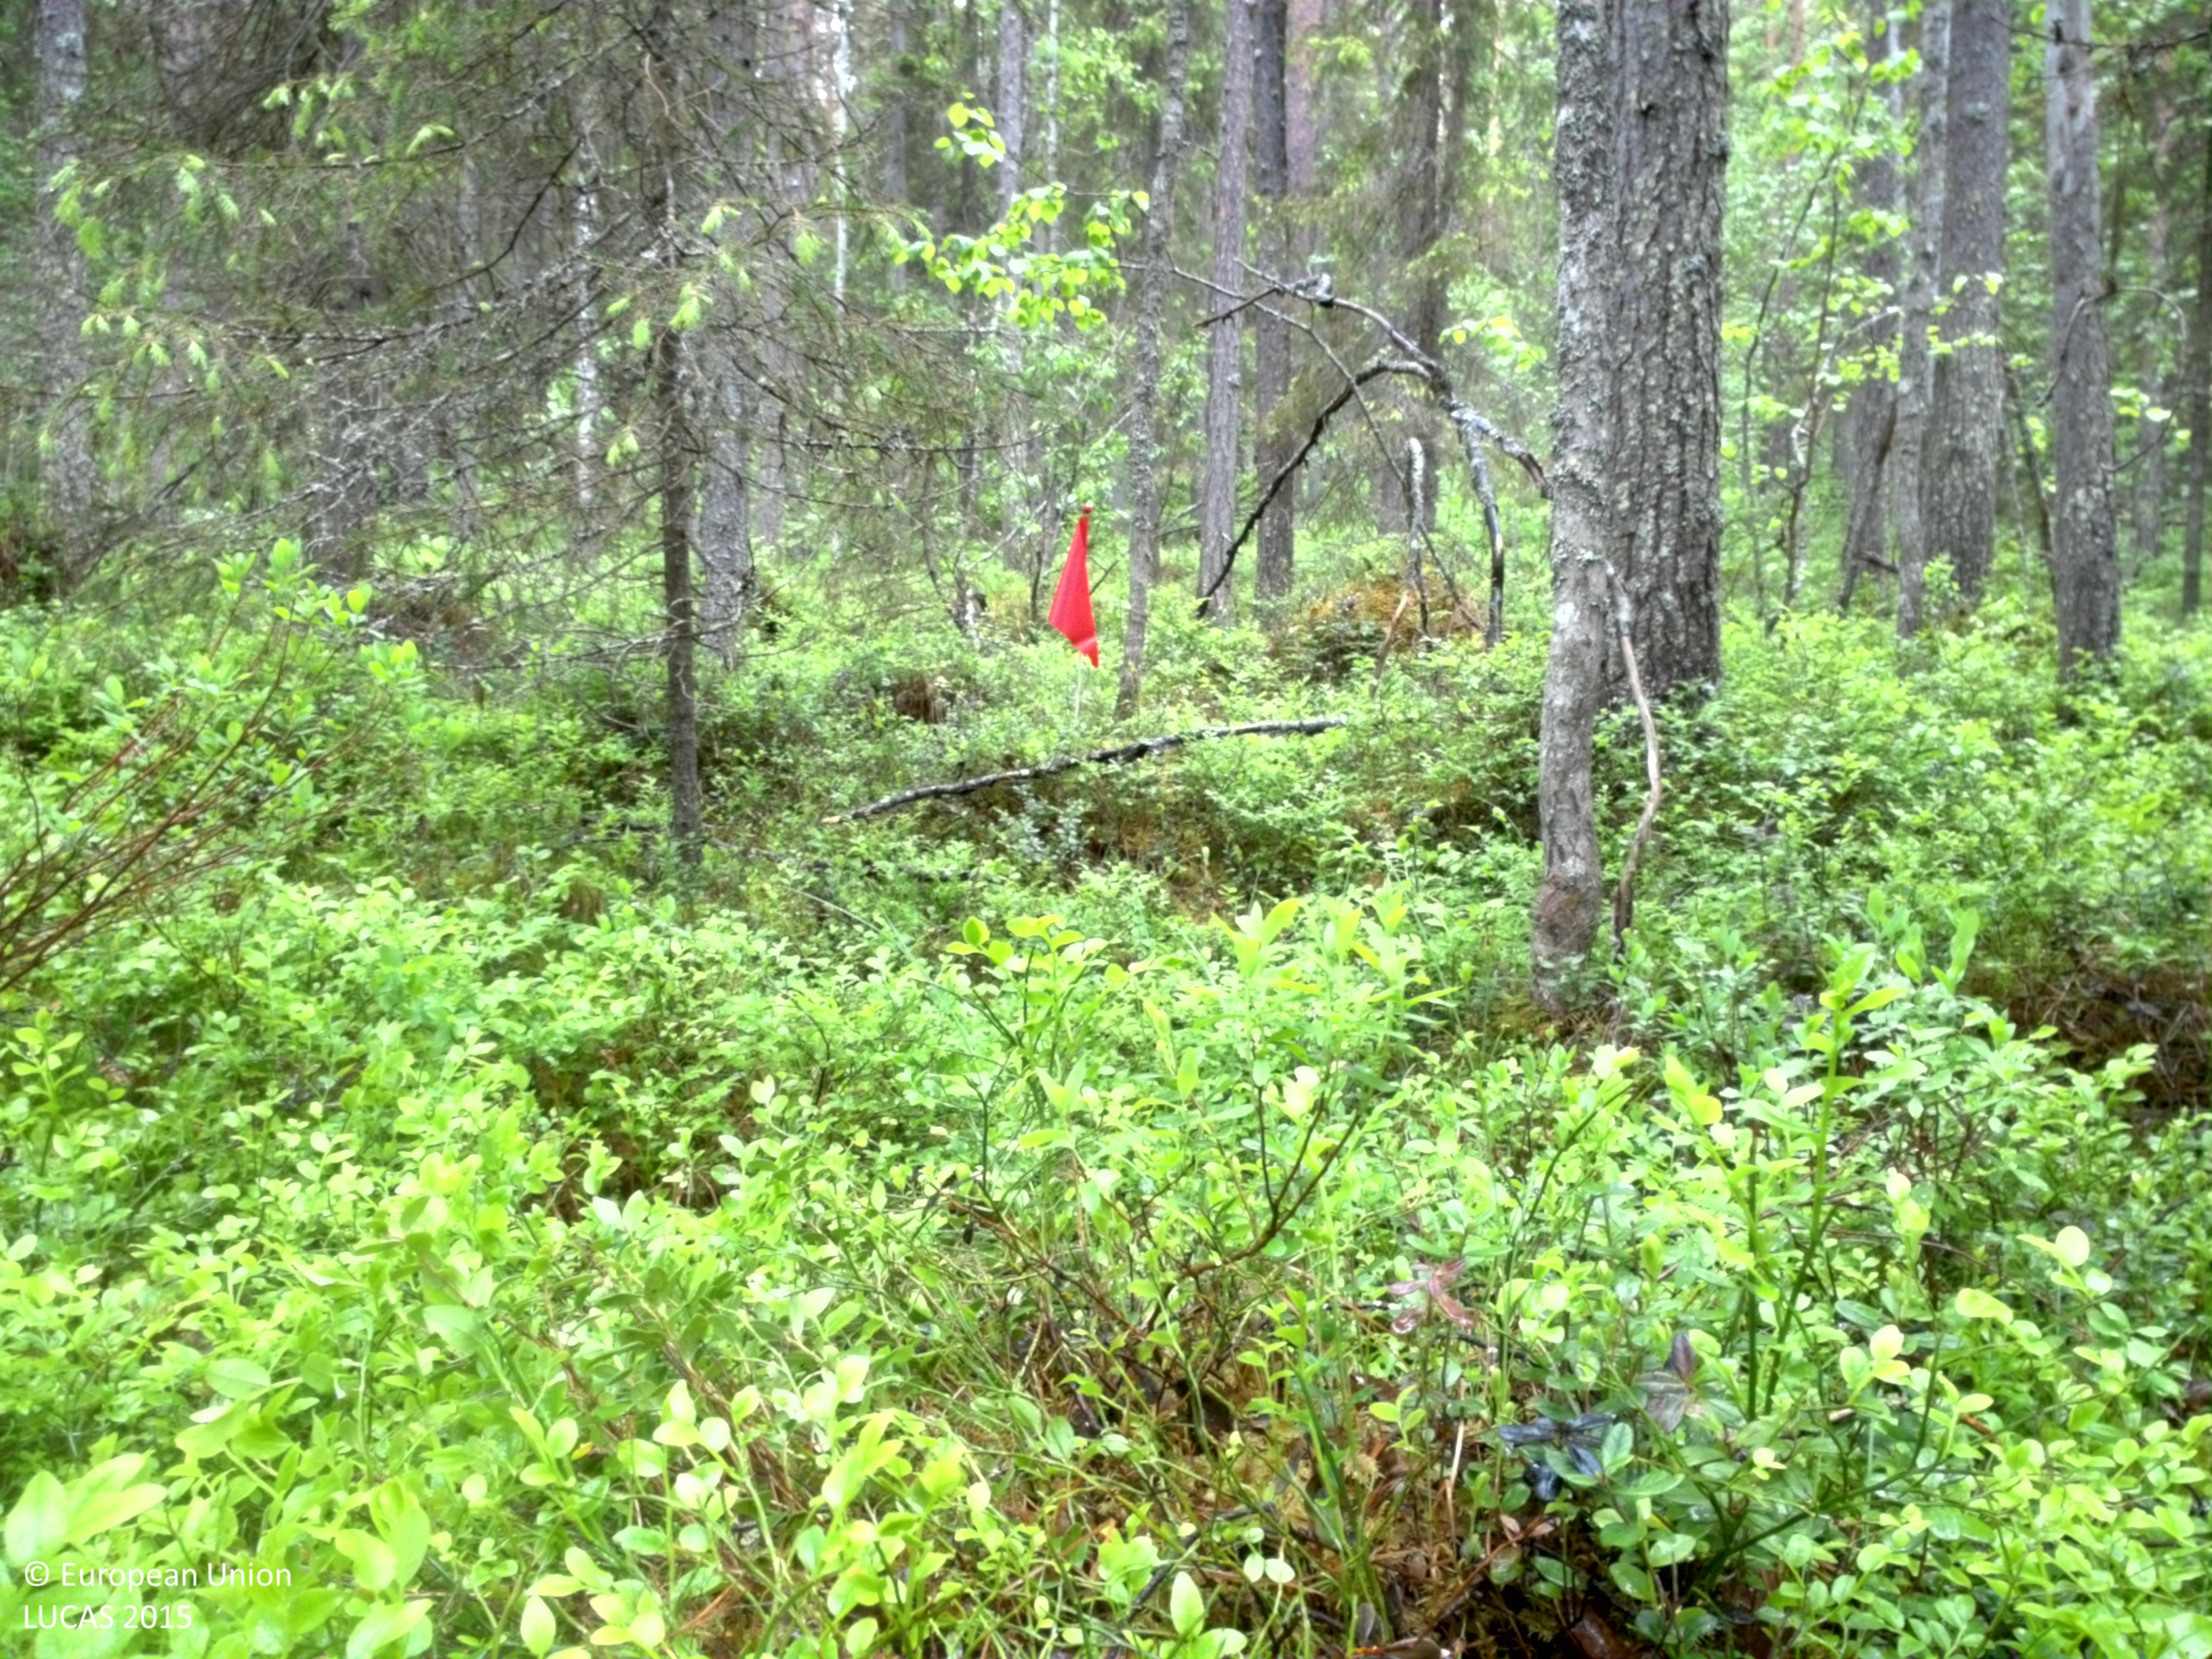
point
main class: Woodland
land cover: Pine dominated coniferous woodland
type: boreal forest
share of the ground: 25 - 50 %
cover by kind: shrubs 55 %, coniferous forest trees 40 %, broadleaved forest trees 5 %
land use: Forestry
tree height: > 5 m
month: June
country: SE
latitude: 66.4326
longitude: 22.7737
